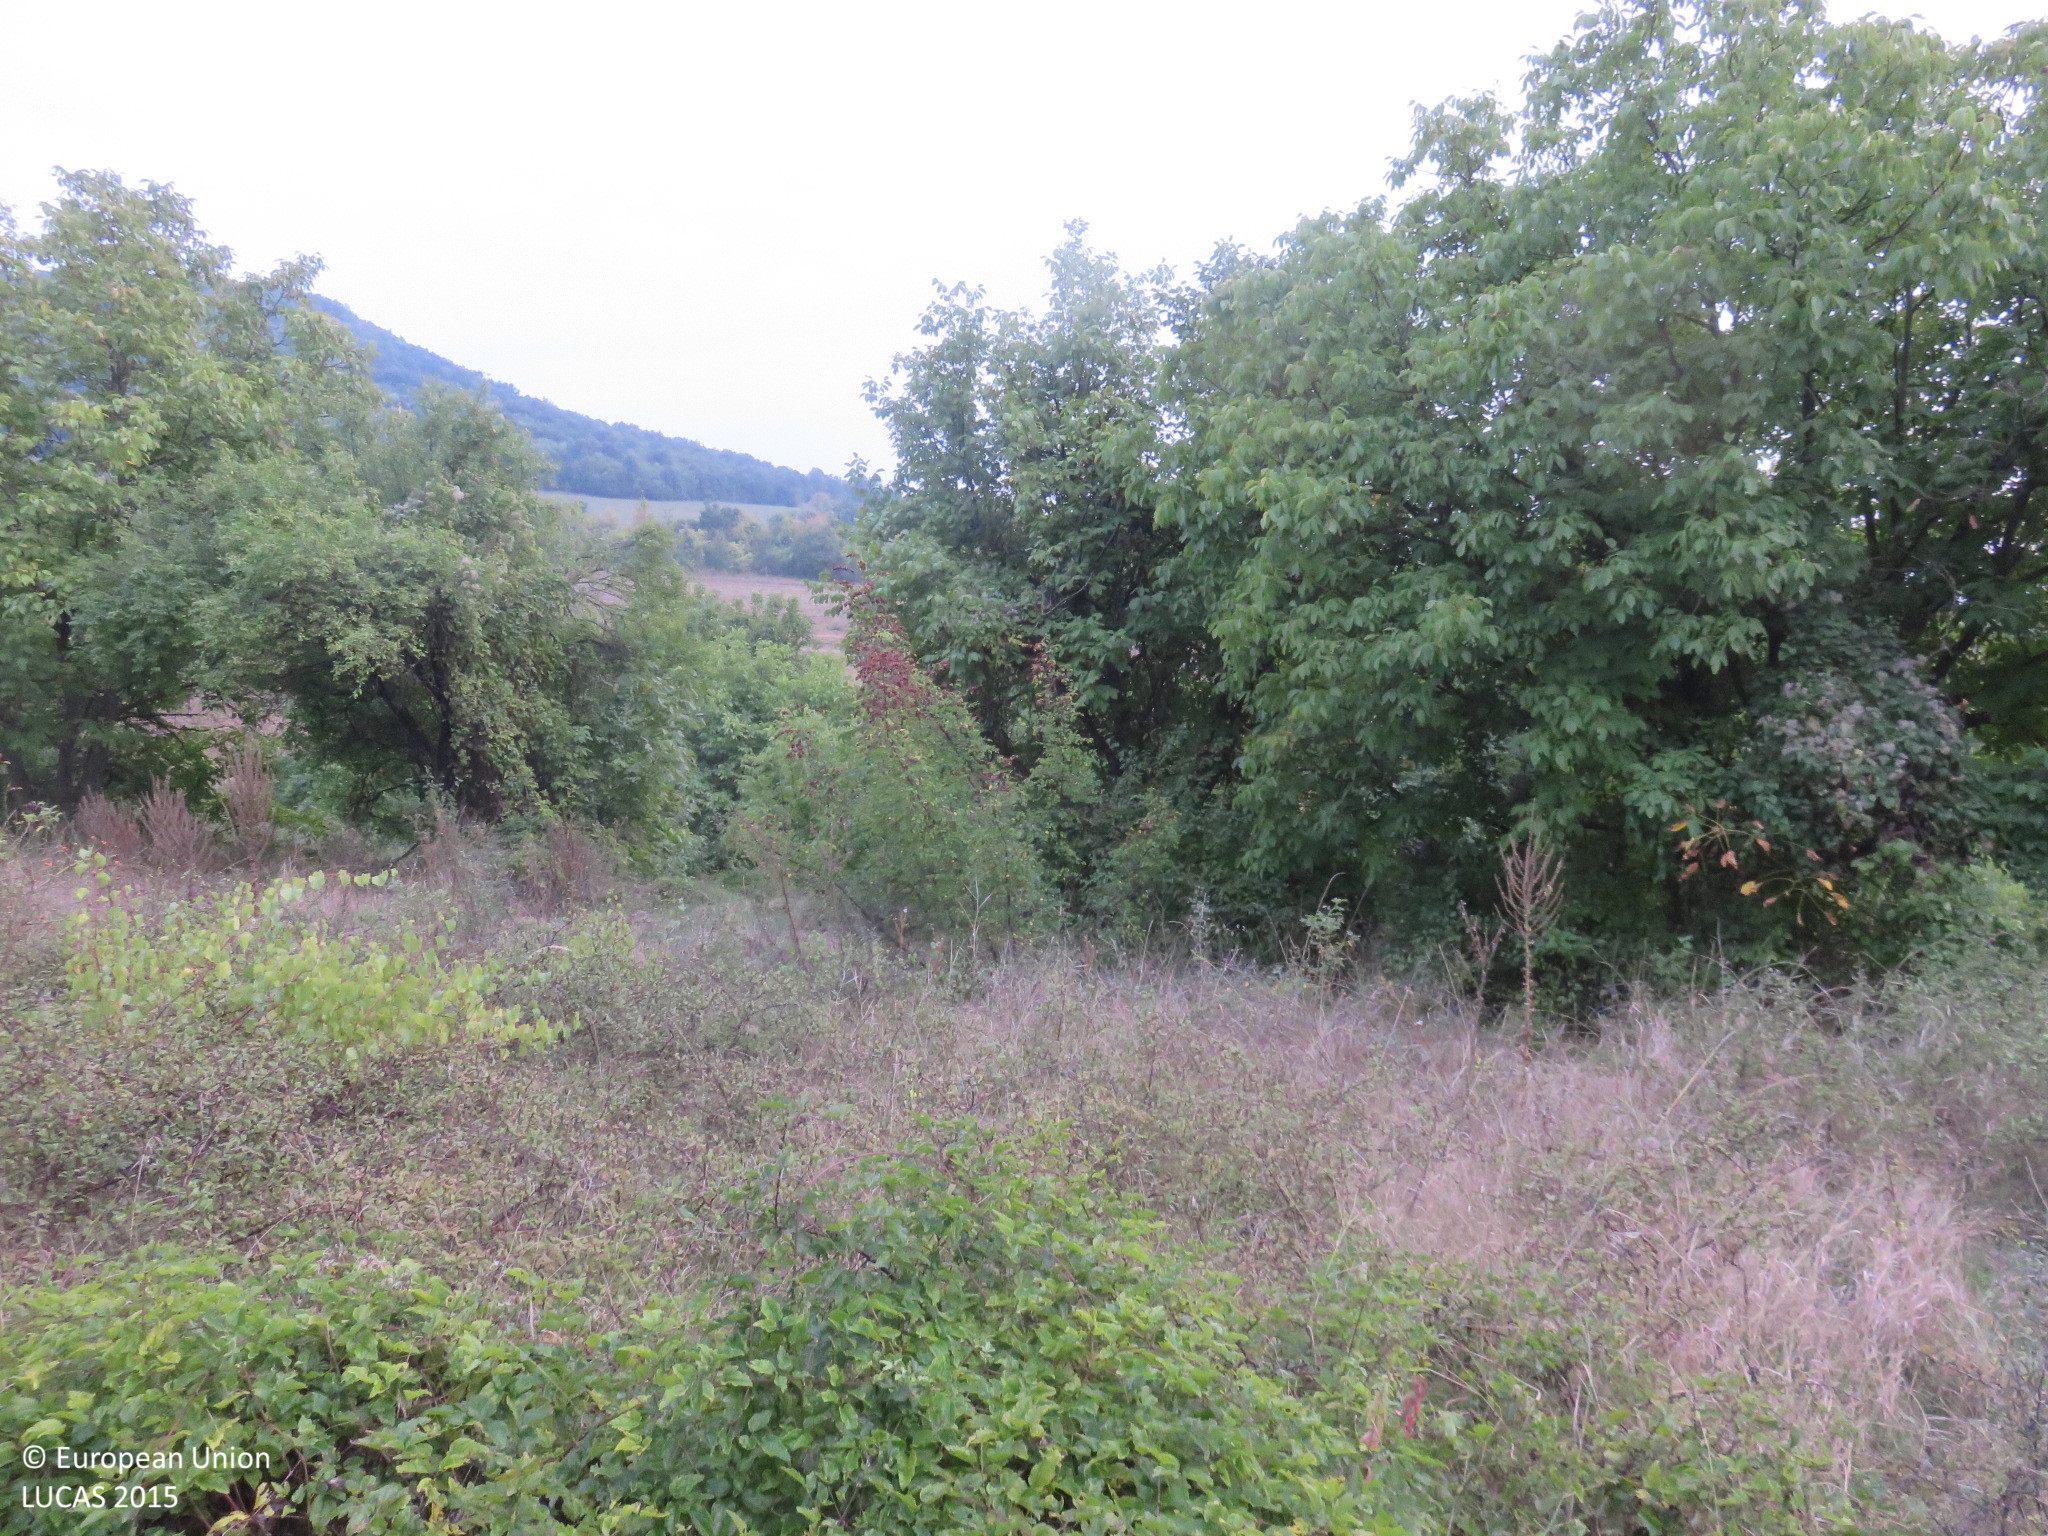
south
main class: Shrubland
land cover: Shrubland with sparse tree cover
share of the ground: > 75 %
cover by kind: shrubs 95 %, broadleaved forest trees 5 %
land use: Abandoned areas
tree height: < 5 m
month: September
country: BG
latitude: 43.1882
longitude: 24.8173
